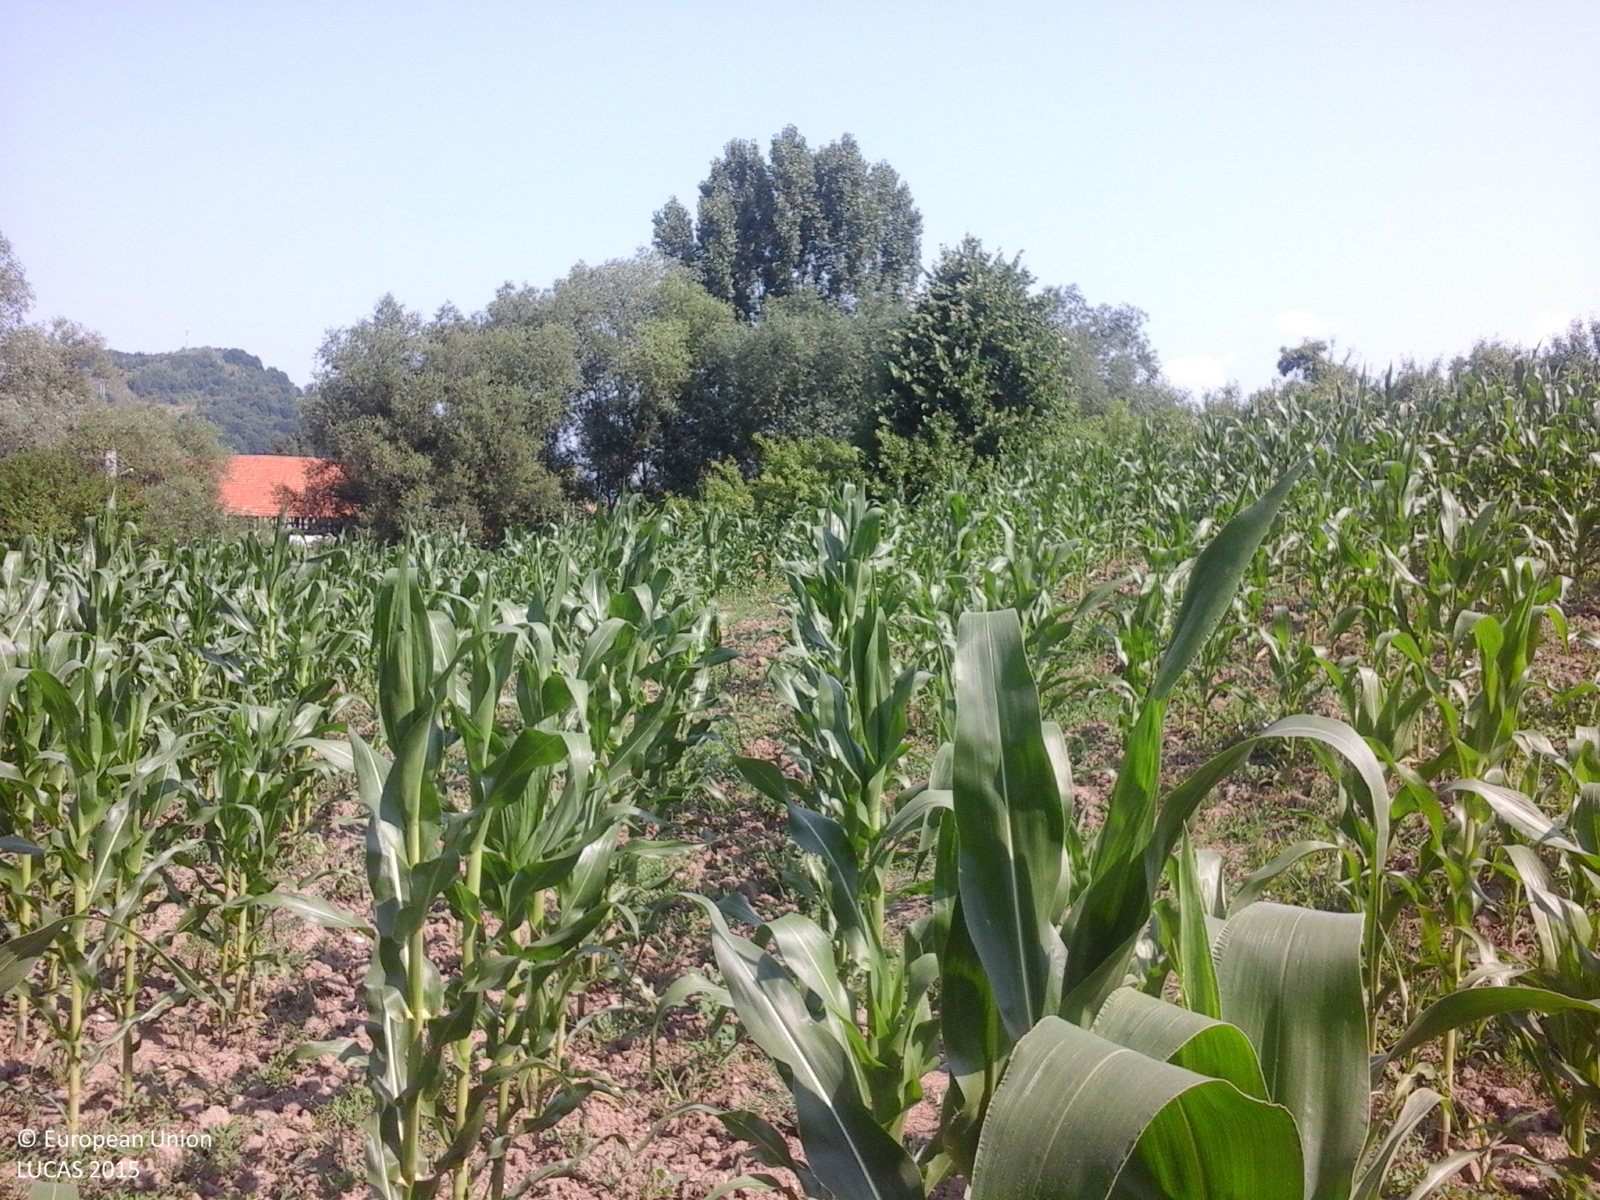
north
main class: Cropland
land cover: Maize
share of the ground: > 75 %
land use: Agriculture (excluding fallow land and kitchen gardens)
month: July
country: RO
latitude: 45.2030
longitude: 24.5532
